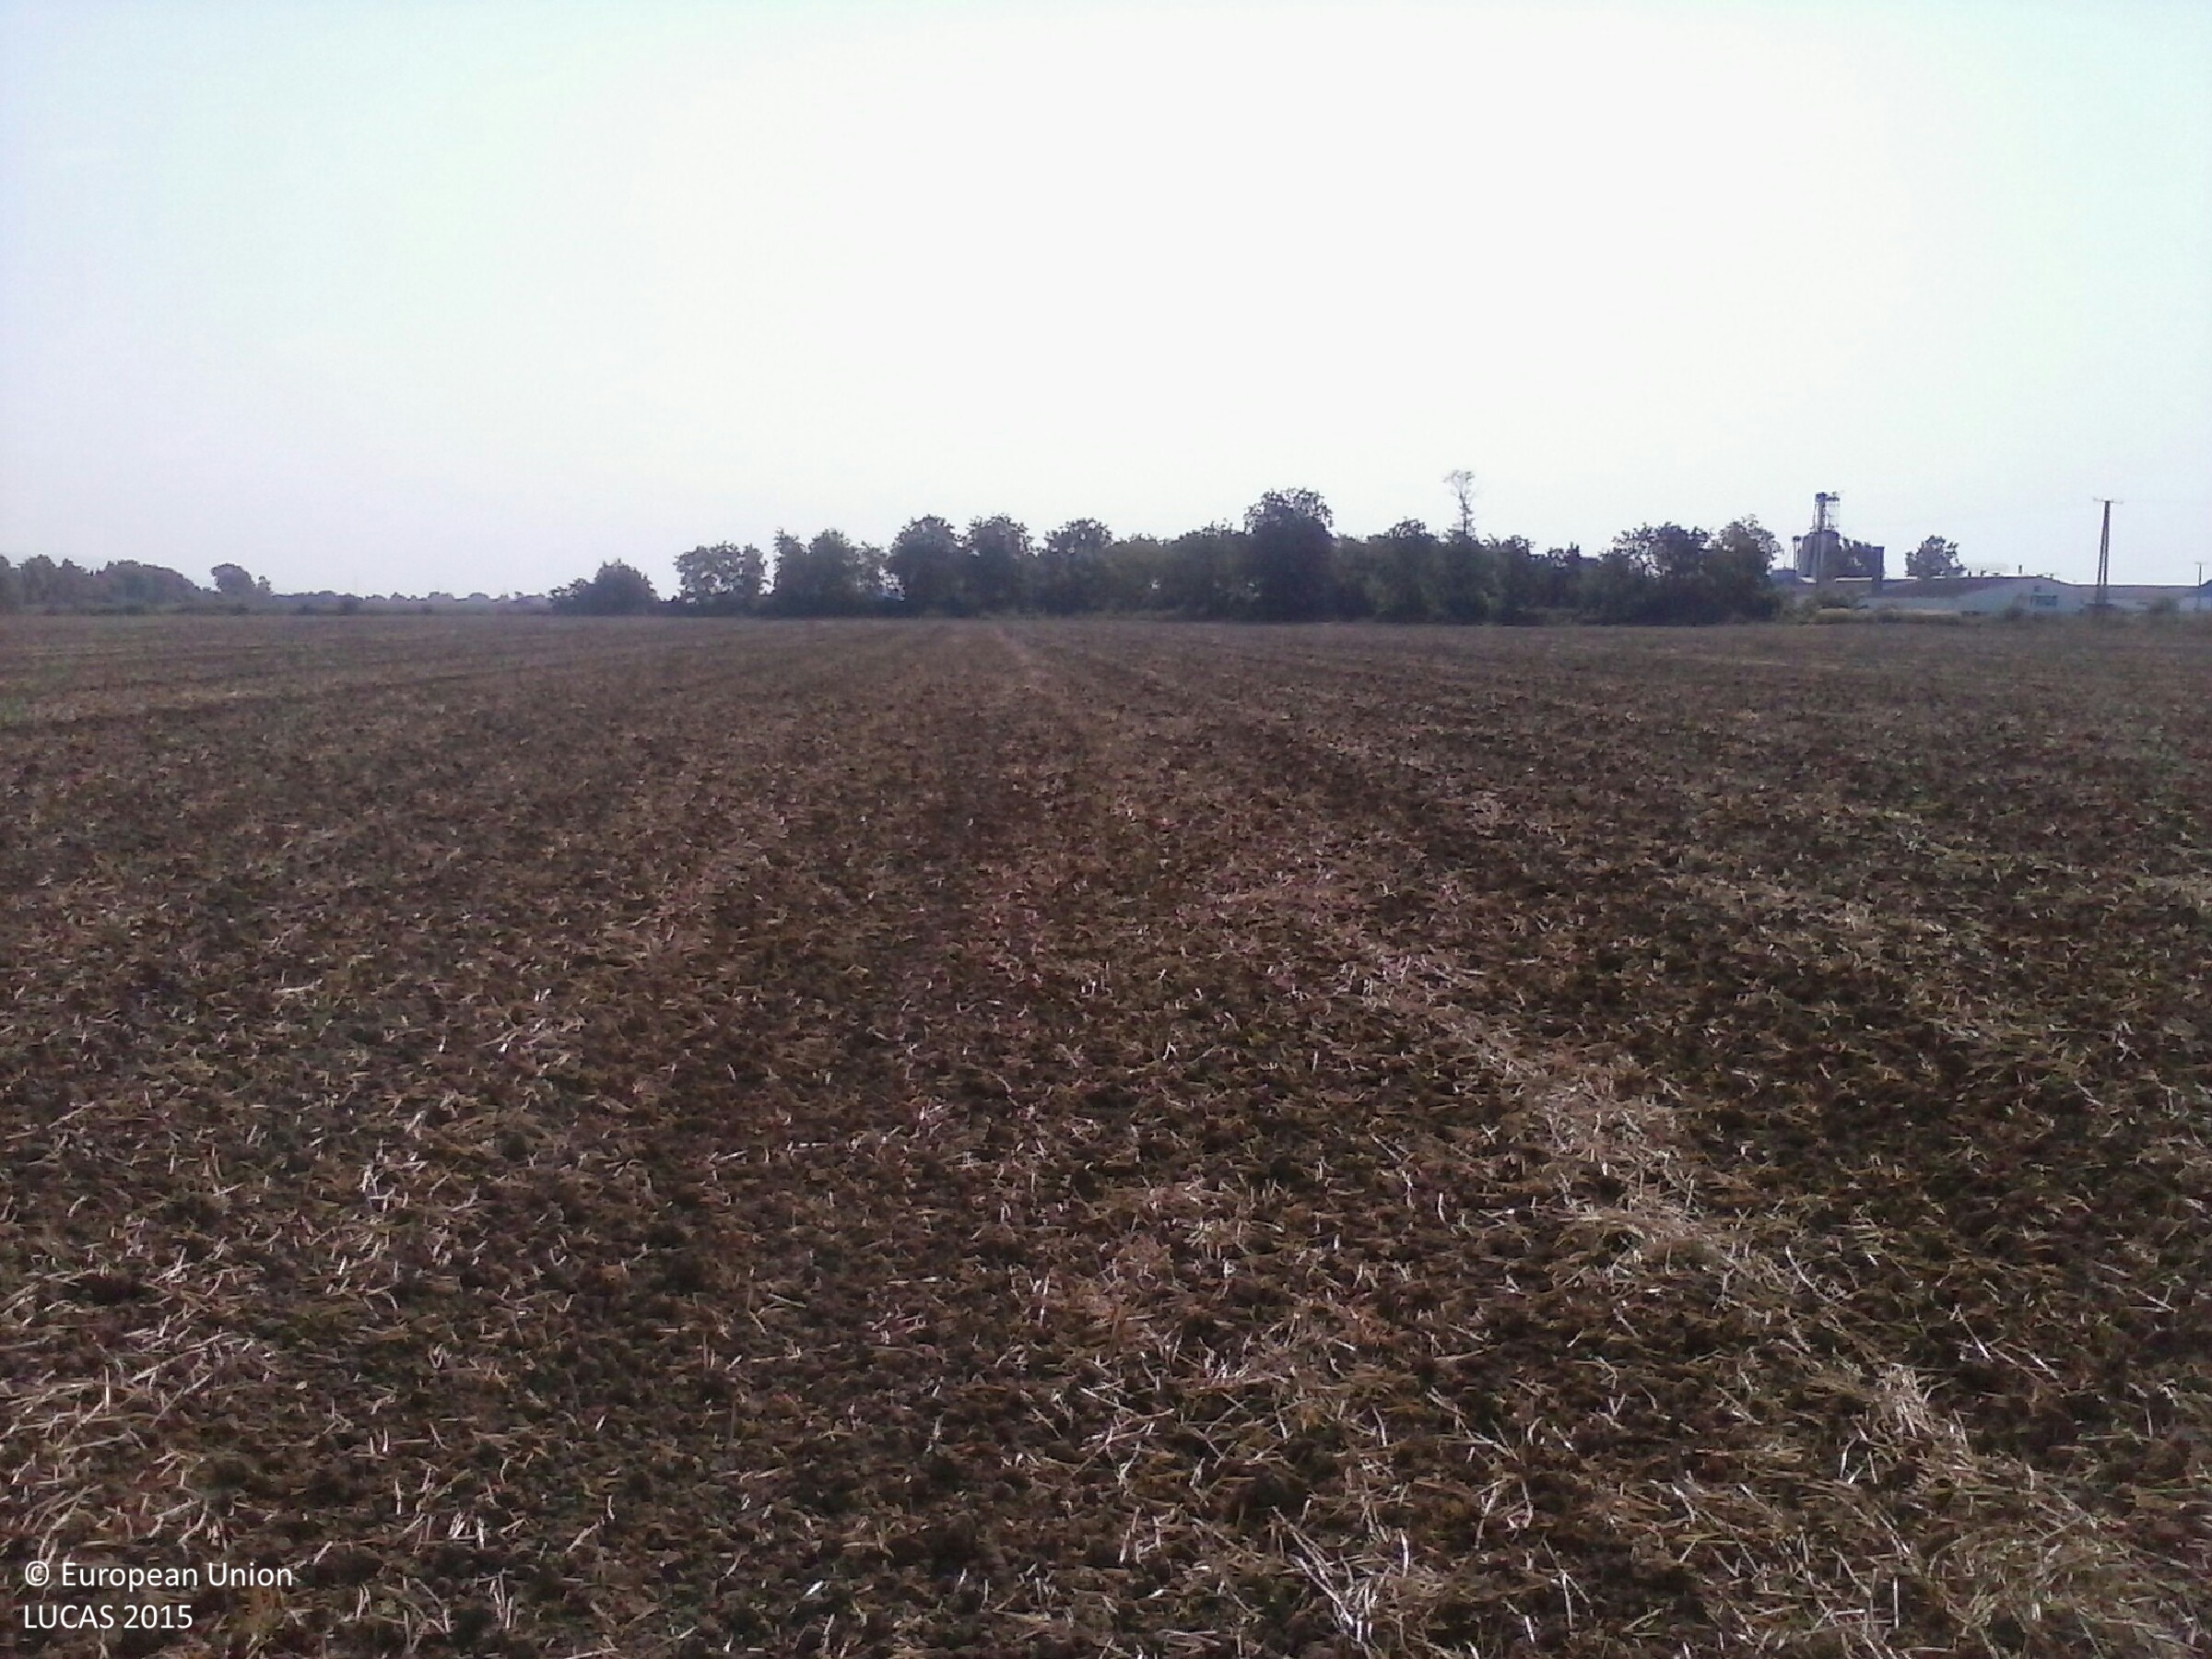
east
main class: Cropland
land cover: Common wheat
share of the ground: < 10 %
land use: Agriculture (excluding fallow land and kitchen gardens)
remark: Harvested field
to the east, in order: Common wheat
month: August
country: HU
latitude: 46.0227
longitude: 17.8979
